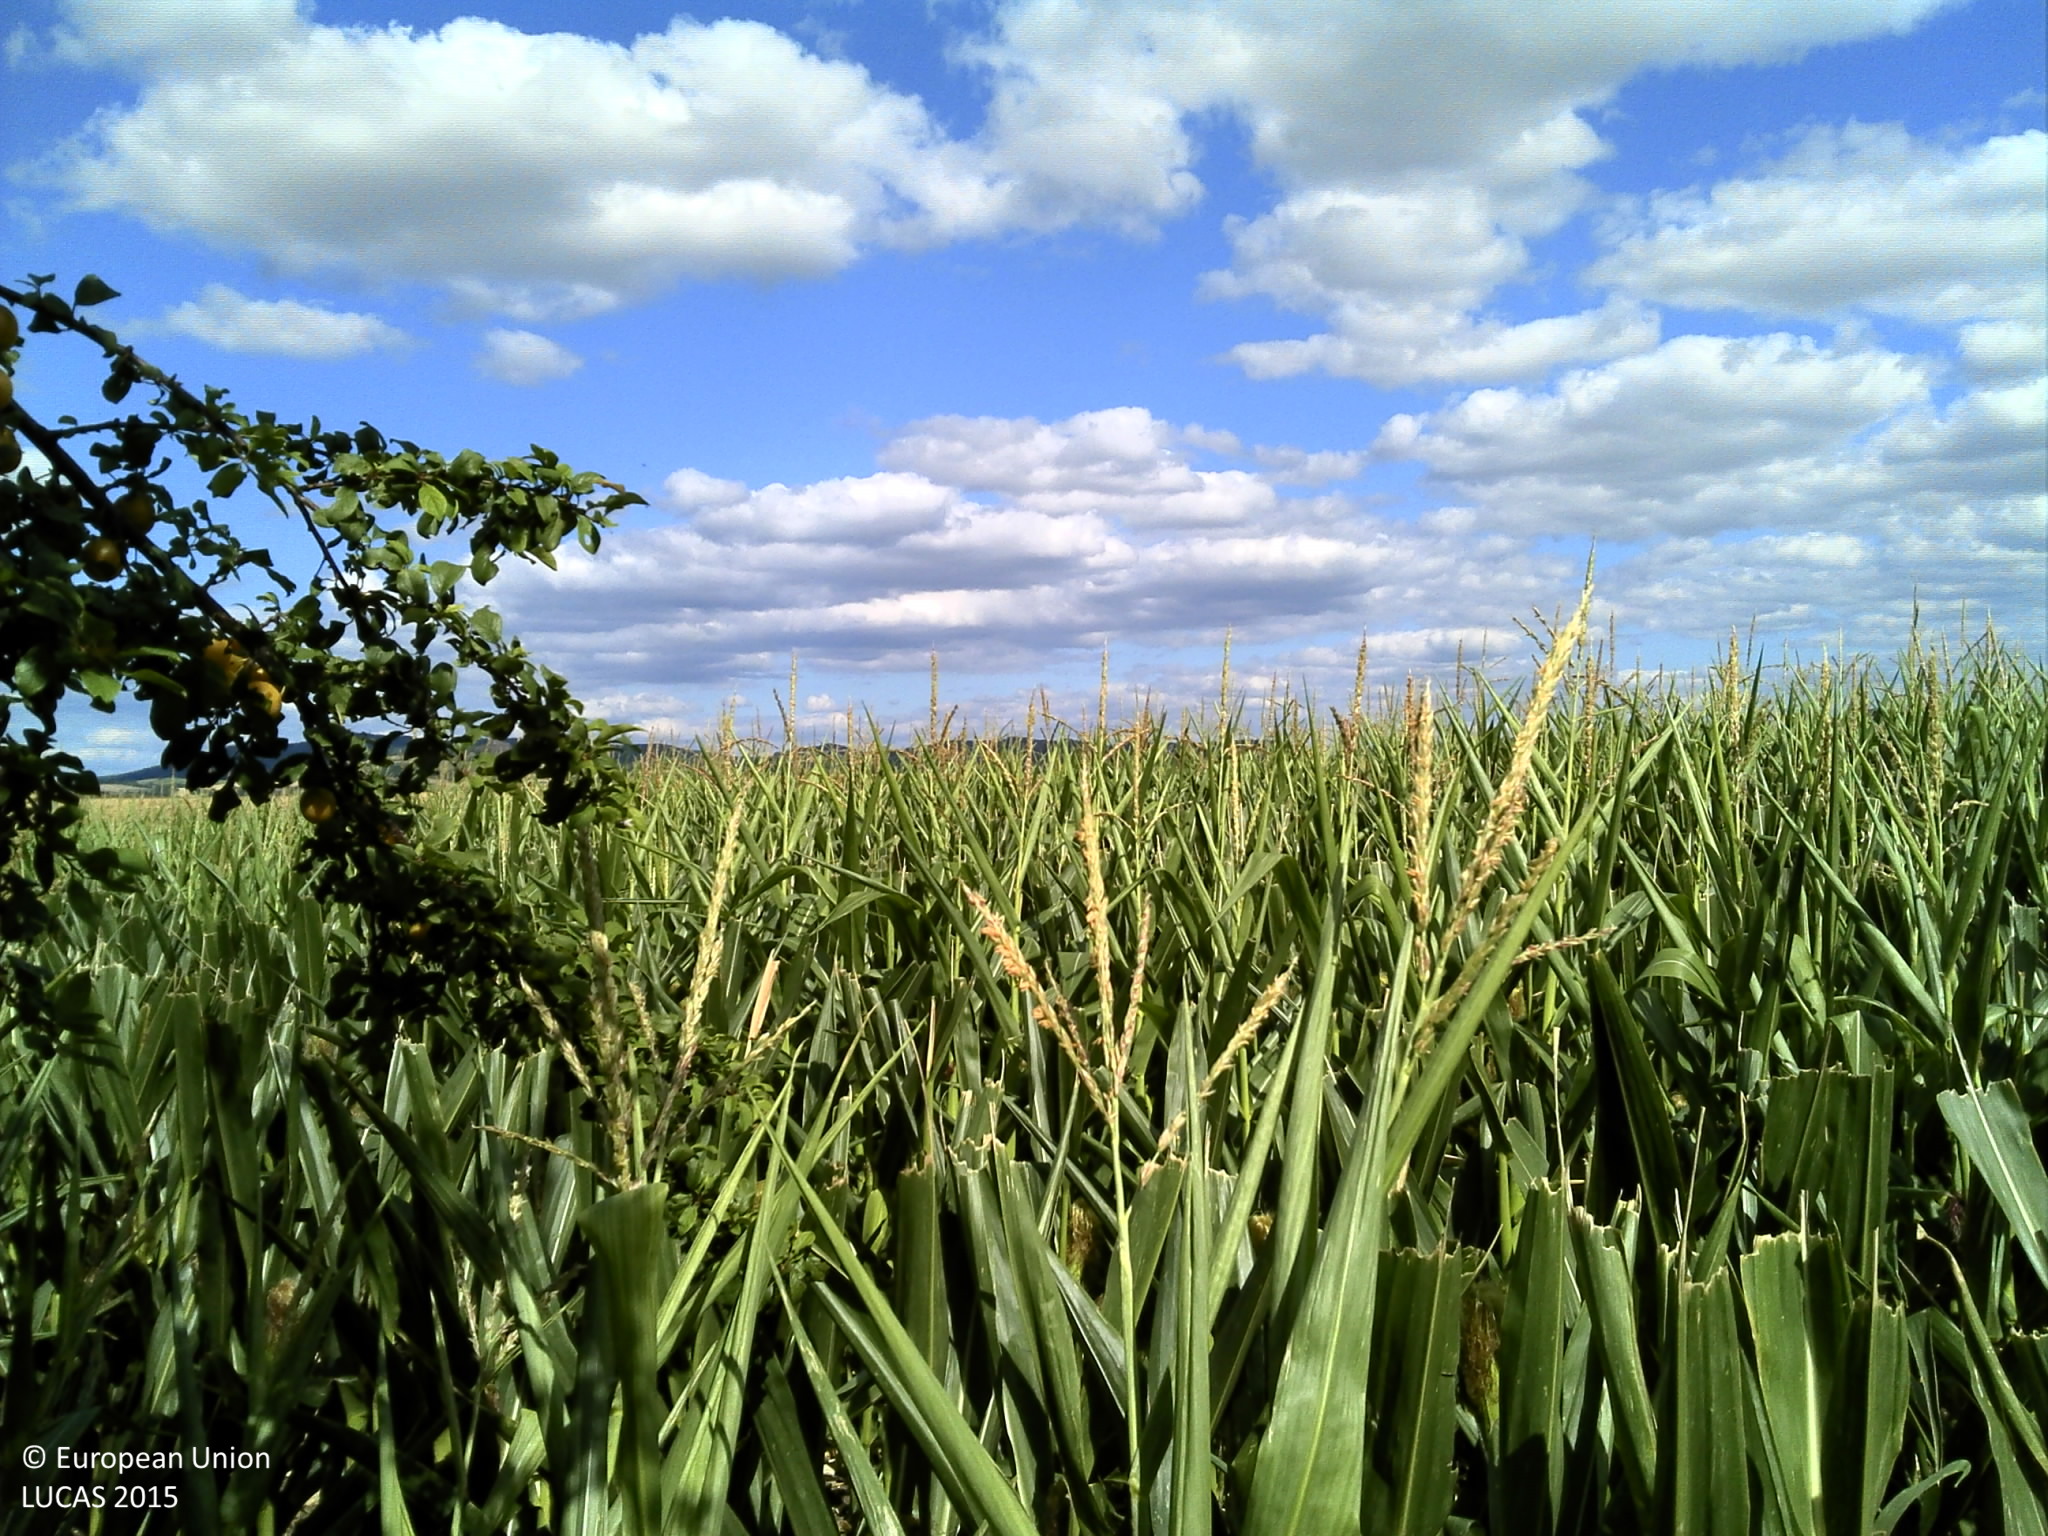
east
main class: Cropland
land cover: Maize
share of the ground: > 75 %
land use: Agriculture (excluding fallow land and kitchen gardens)
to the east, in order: Maize; Tracks; Sunflower
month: July
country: FR
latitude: 45.6083
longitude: 3.1662
